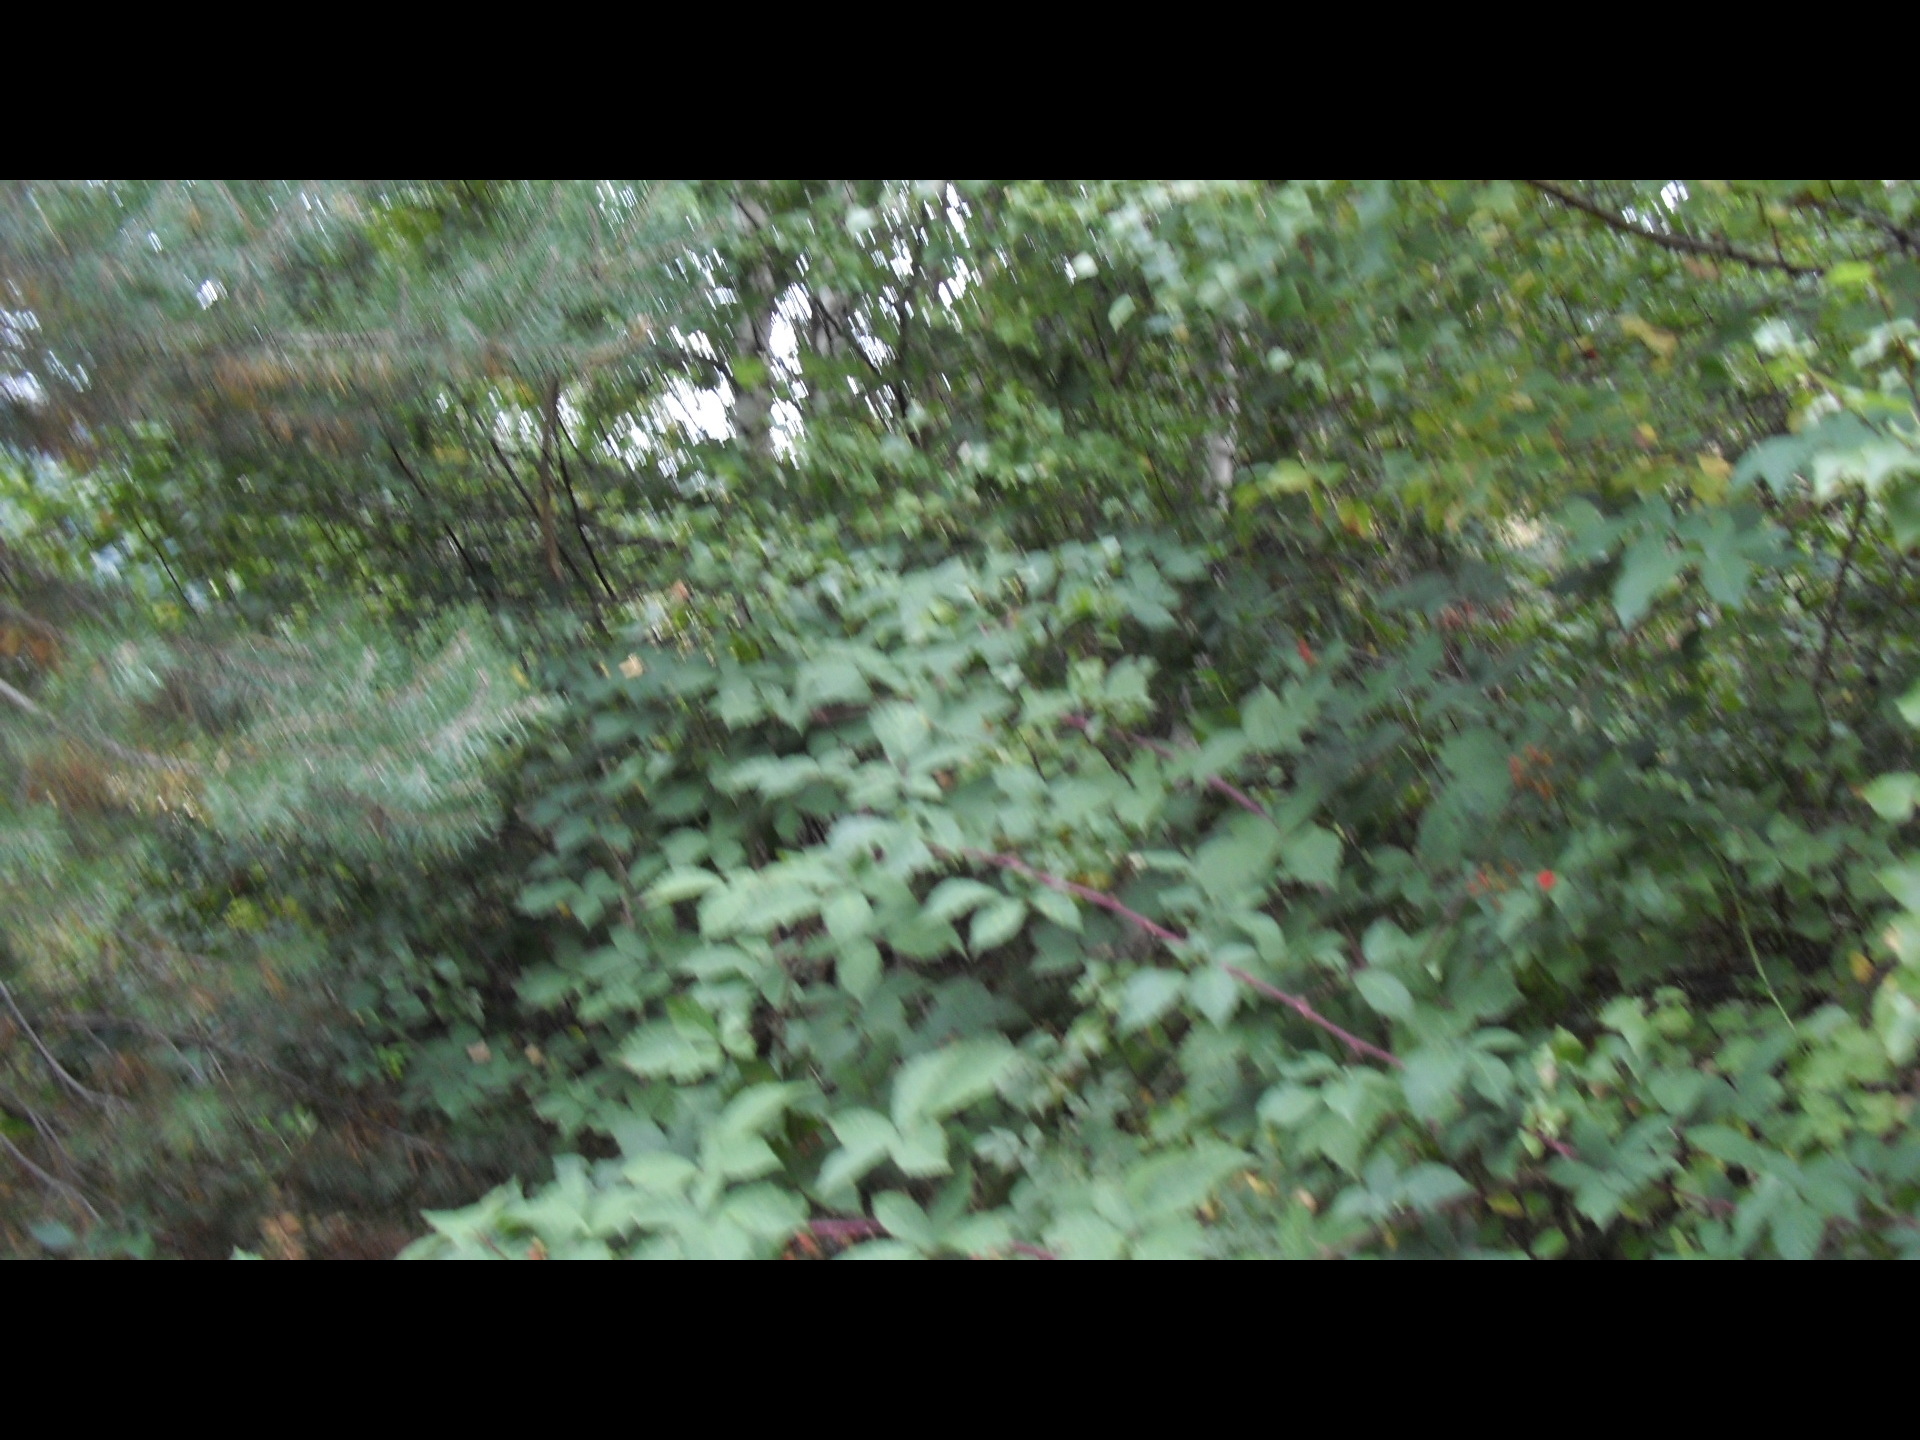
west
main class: Woodland
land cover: Broadleaved woodland
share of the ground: > 75 %
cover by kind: broadleaved forest trees 85 %, coniferous forest trees 10 %, shrubs 5 %
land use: Semi-natural and natural areas not in use
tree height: < 5 m
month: October
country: BG
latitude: 43.3887
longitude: 22.8104
